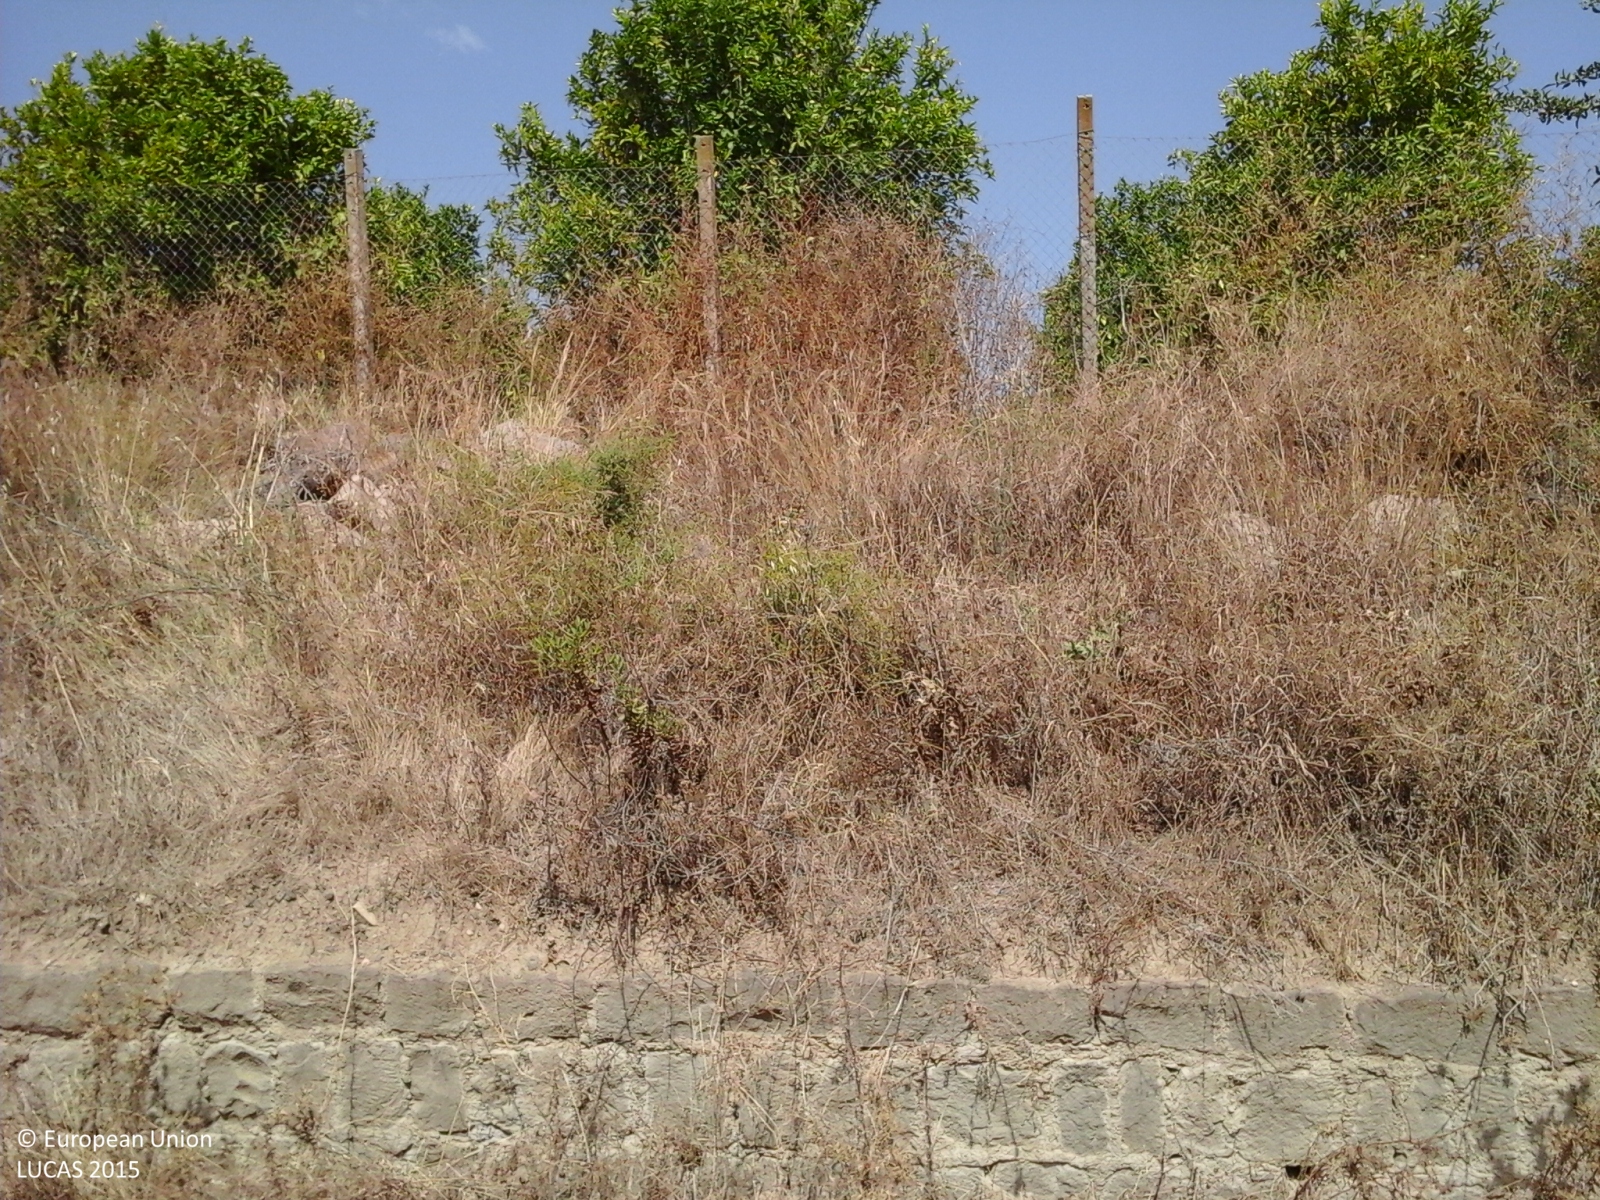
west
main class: Cropland
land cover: Oranges
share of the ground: > 75 %
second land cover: Spontaneously vegetated surfaces
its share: > 75 %
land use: Agriculture (excluding fallow land and kitchen gardens)
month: August
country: IT
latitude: 37.2784
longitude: 14.8471
